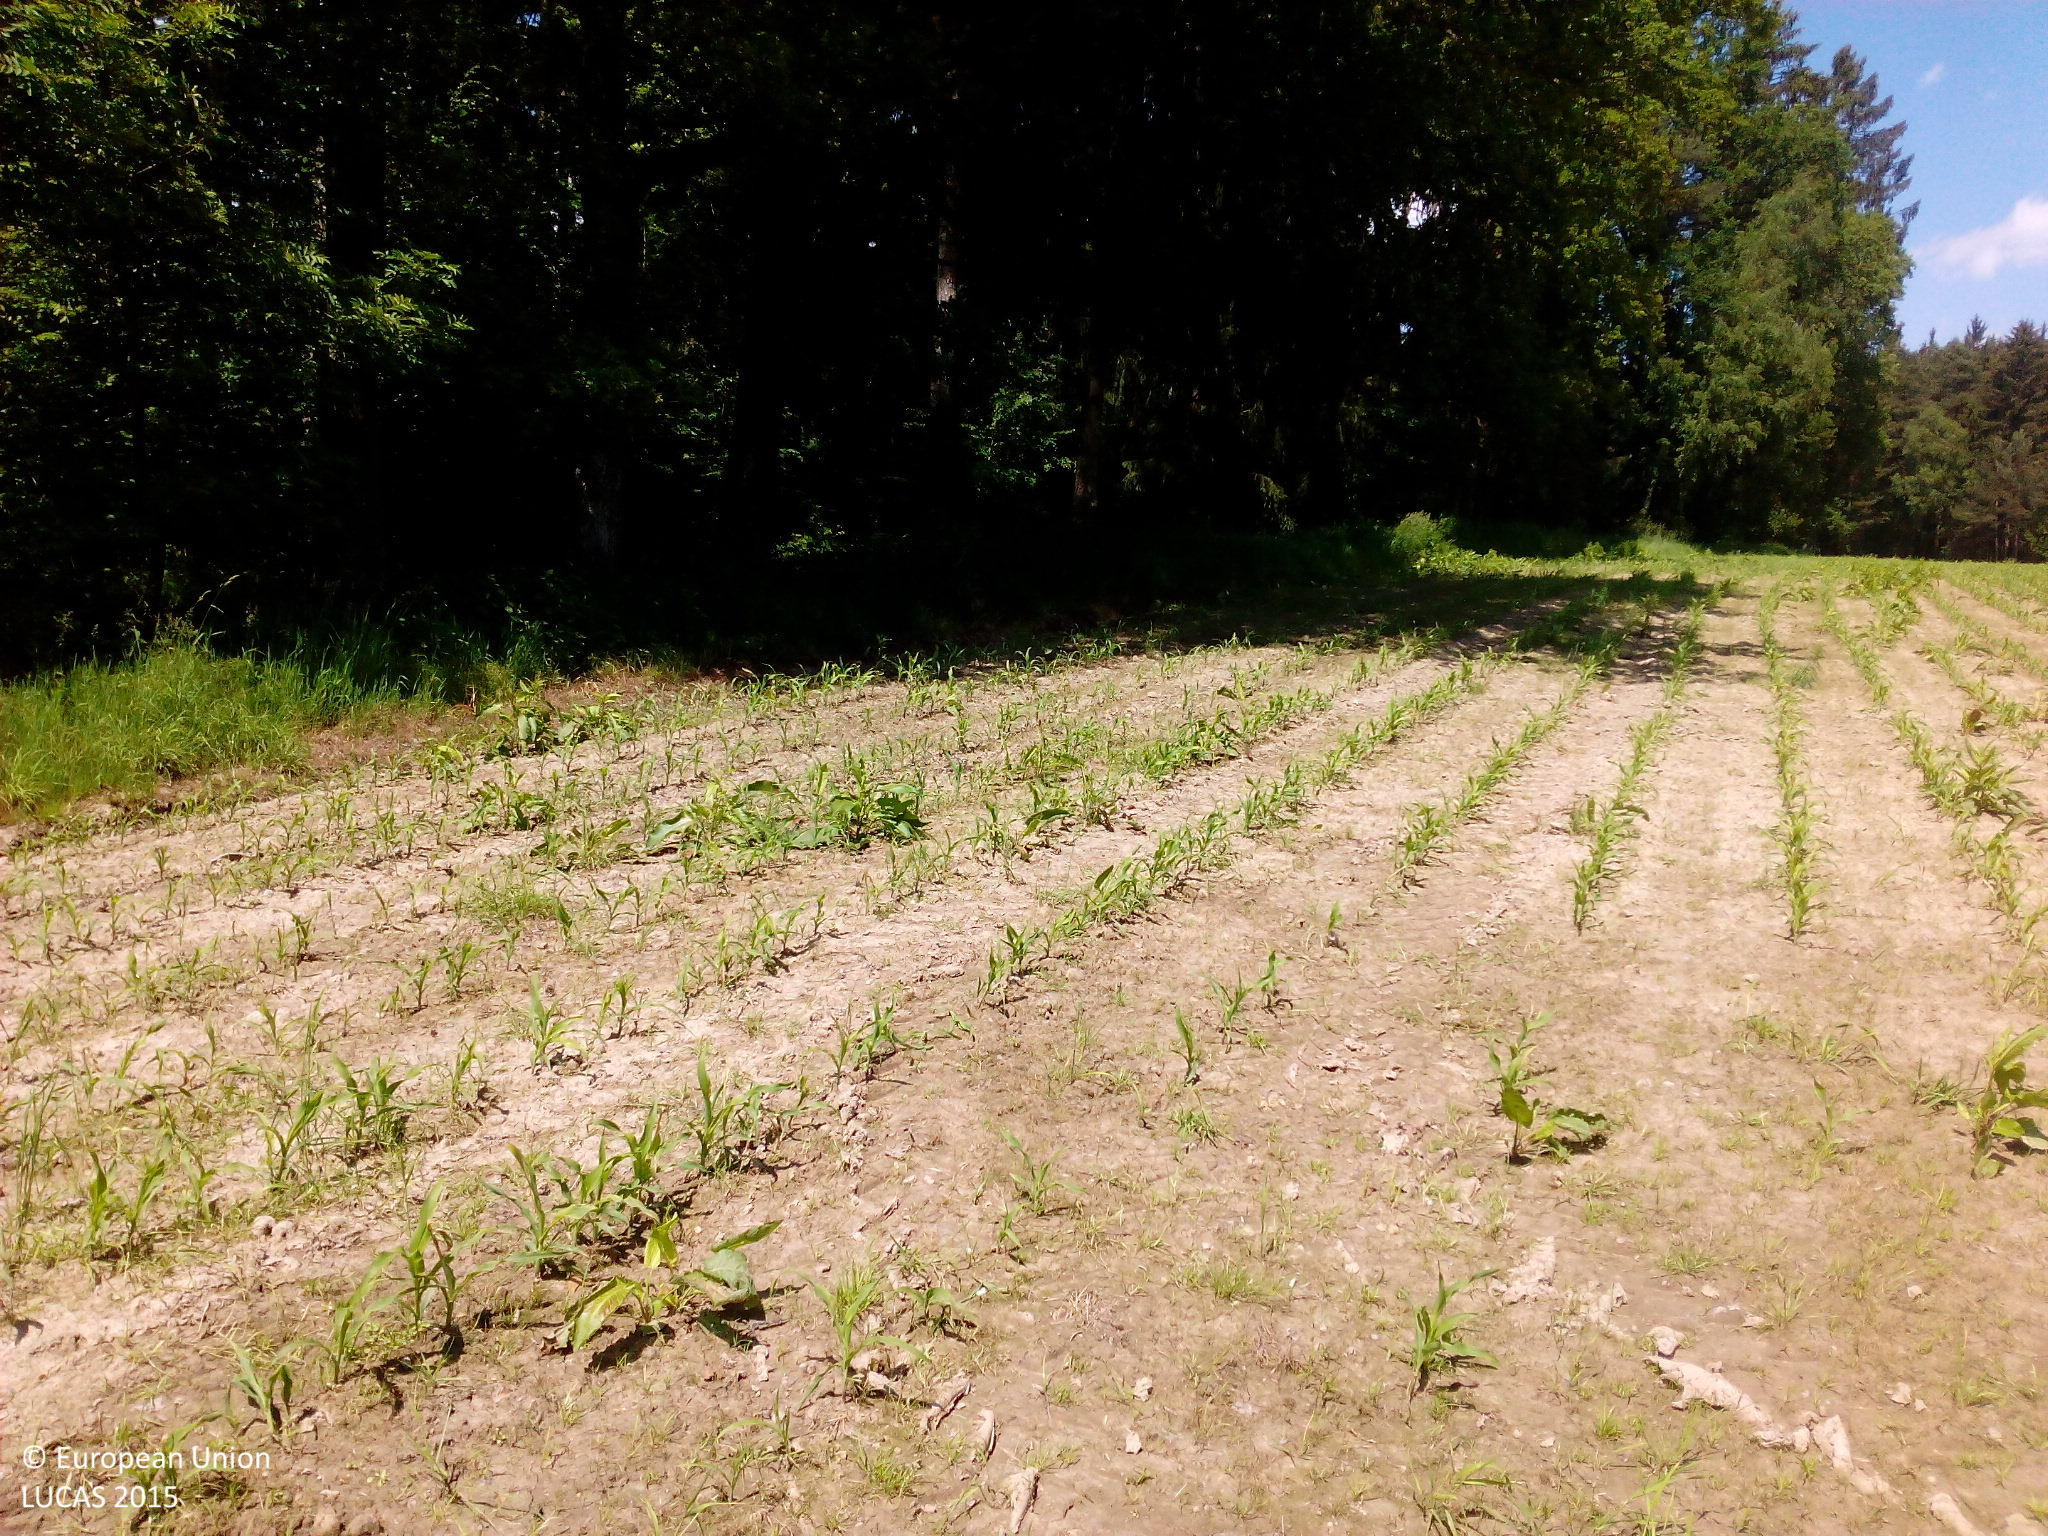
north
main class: Cropland
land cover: Maize
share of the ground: < 10 %
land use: Agriculture (excluding fallow land and kitchen gardens)
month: June
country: DE
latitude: 48.5216
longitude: 12.3956
